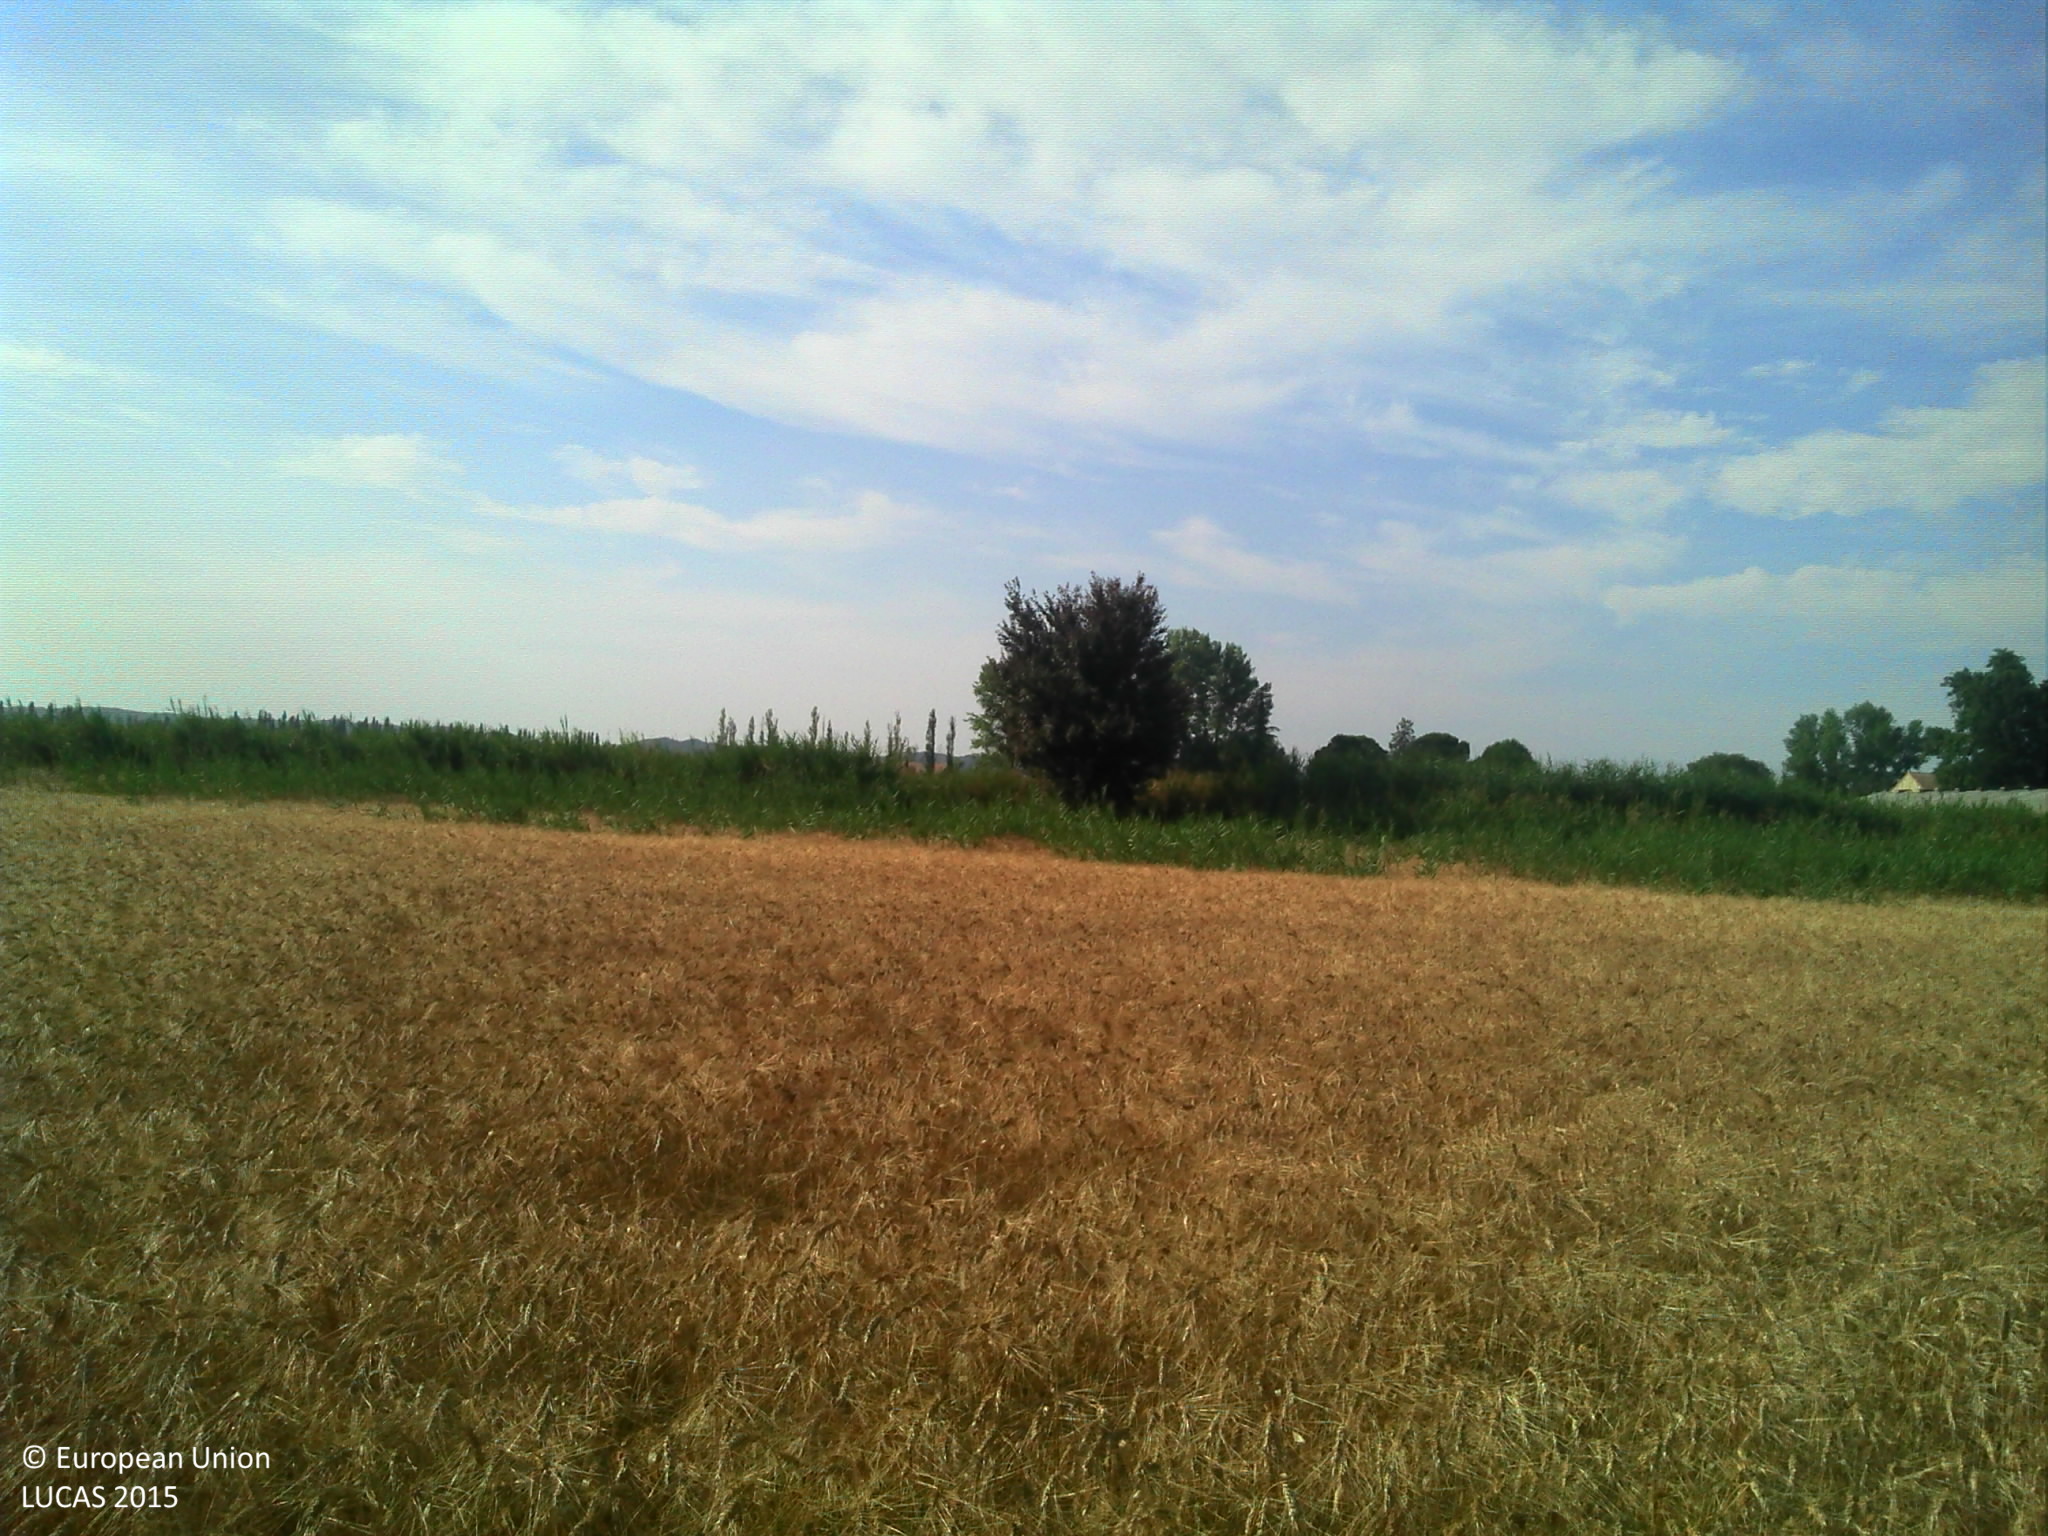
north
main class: Cropland
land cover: Durum wheat
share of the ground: > 75 %
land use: Agriculture (excluding fallow land and kitchen gardens)
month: July
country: FR
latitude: 43.8033
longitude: 4.7760
